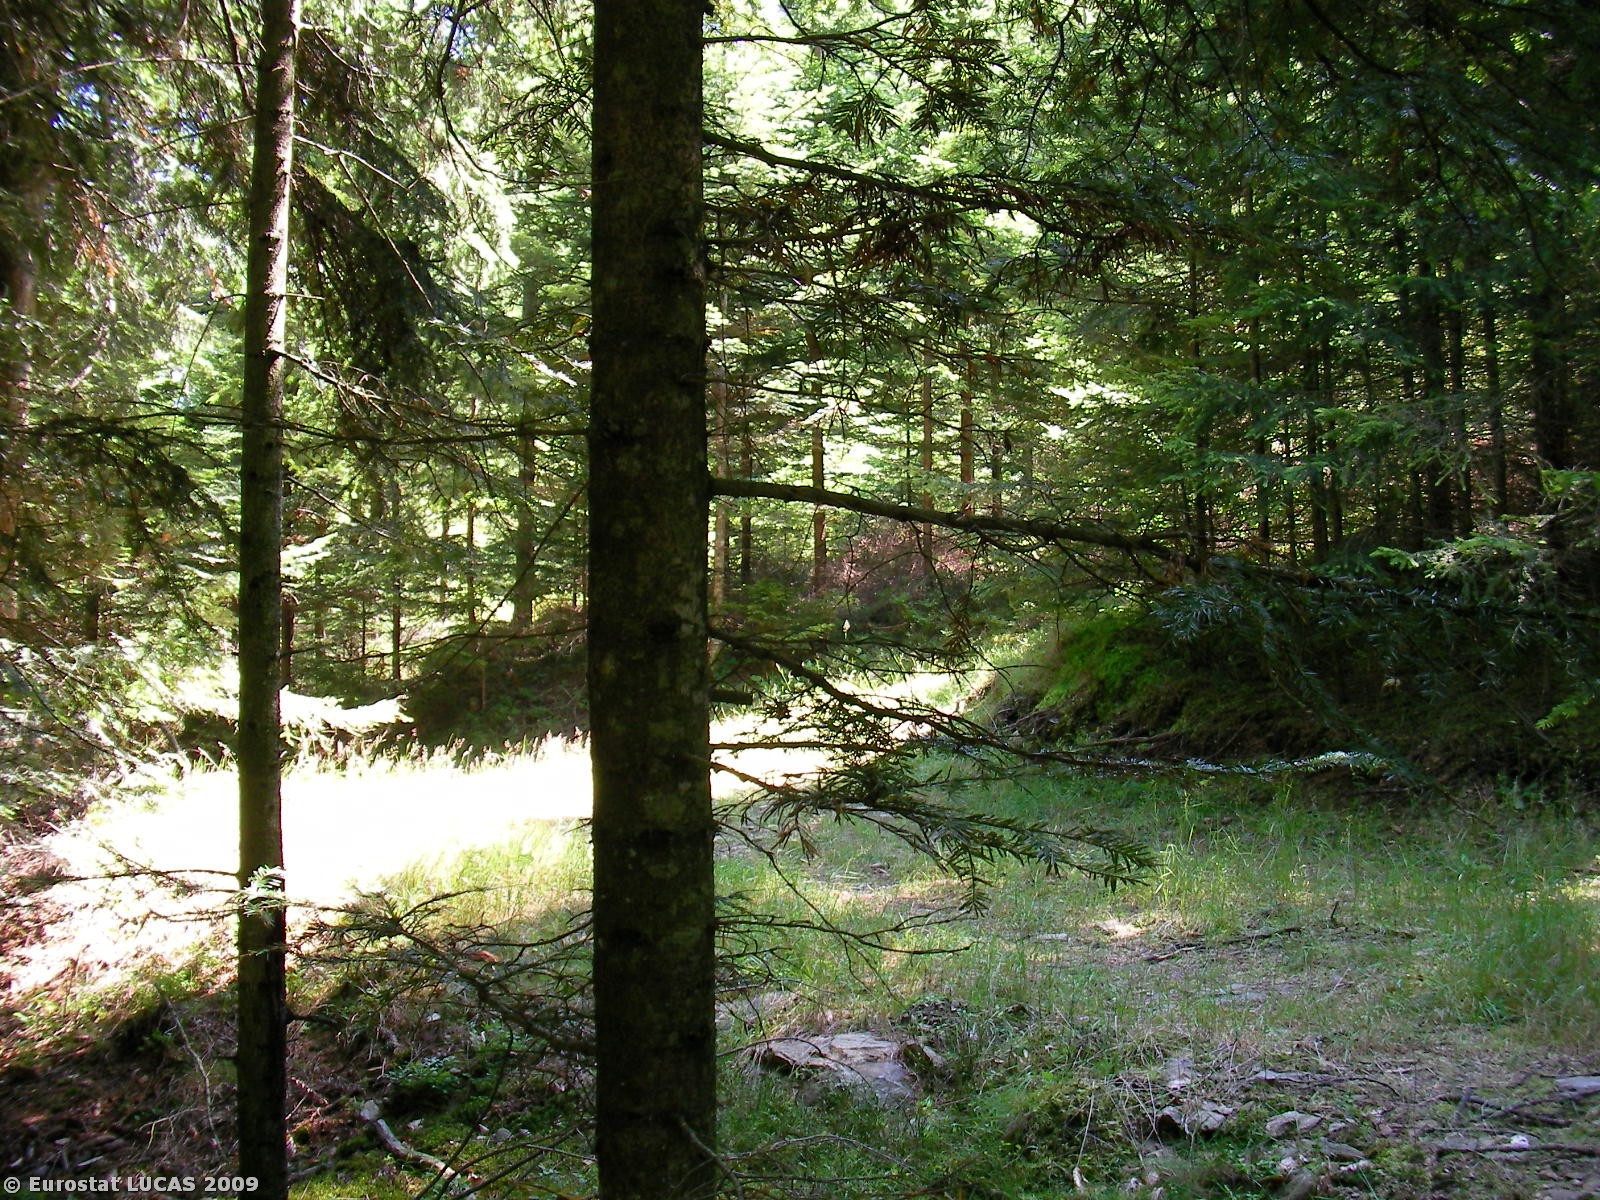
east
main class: Woodland
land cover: Coniferous woodland
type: alpine coniferous forest
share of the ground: > 75 %
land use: Forestry
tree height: > 5 m
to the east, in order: Coniferous woodland; Tracks; Coniferous woodland; Tracks; Coniferous woodland; Shrubland with sparse tree cover; Coniferous woodland; Grass margins; Tracks; Grassland without tree/shrub cover; Grassland with sparse tree/shrub cover; Tracks; Coniferous woodland
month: July
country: AT
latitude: 47.3347
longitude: 15.7314
